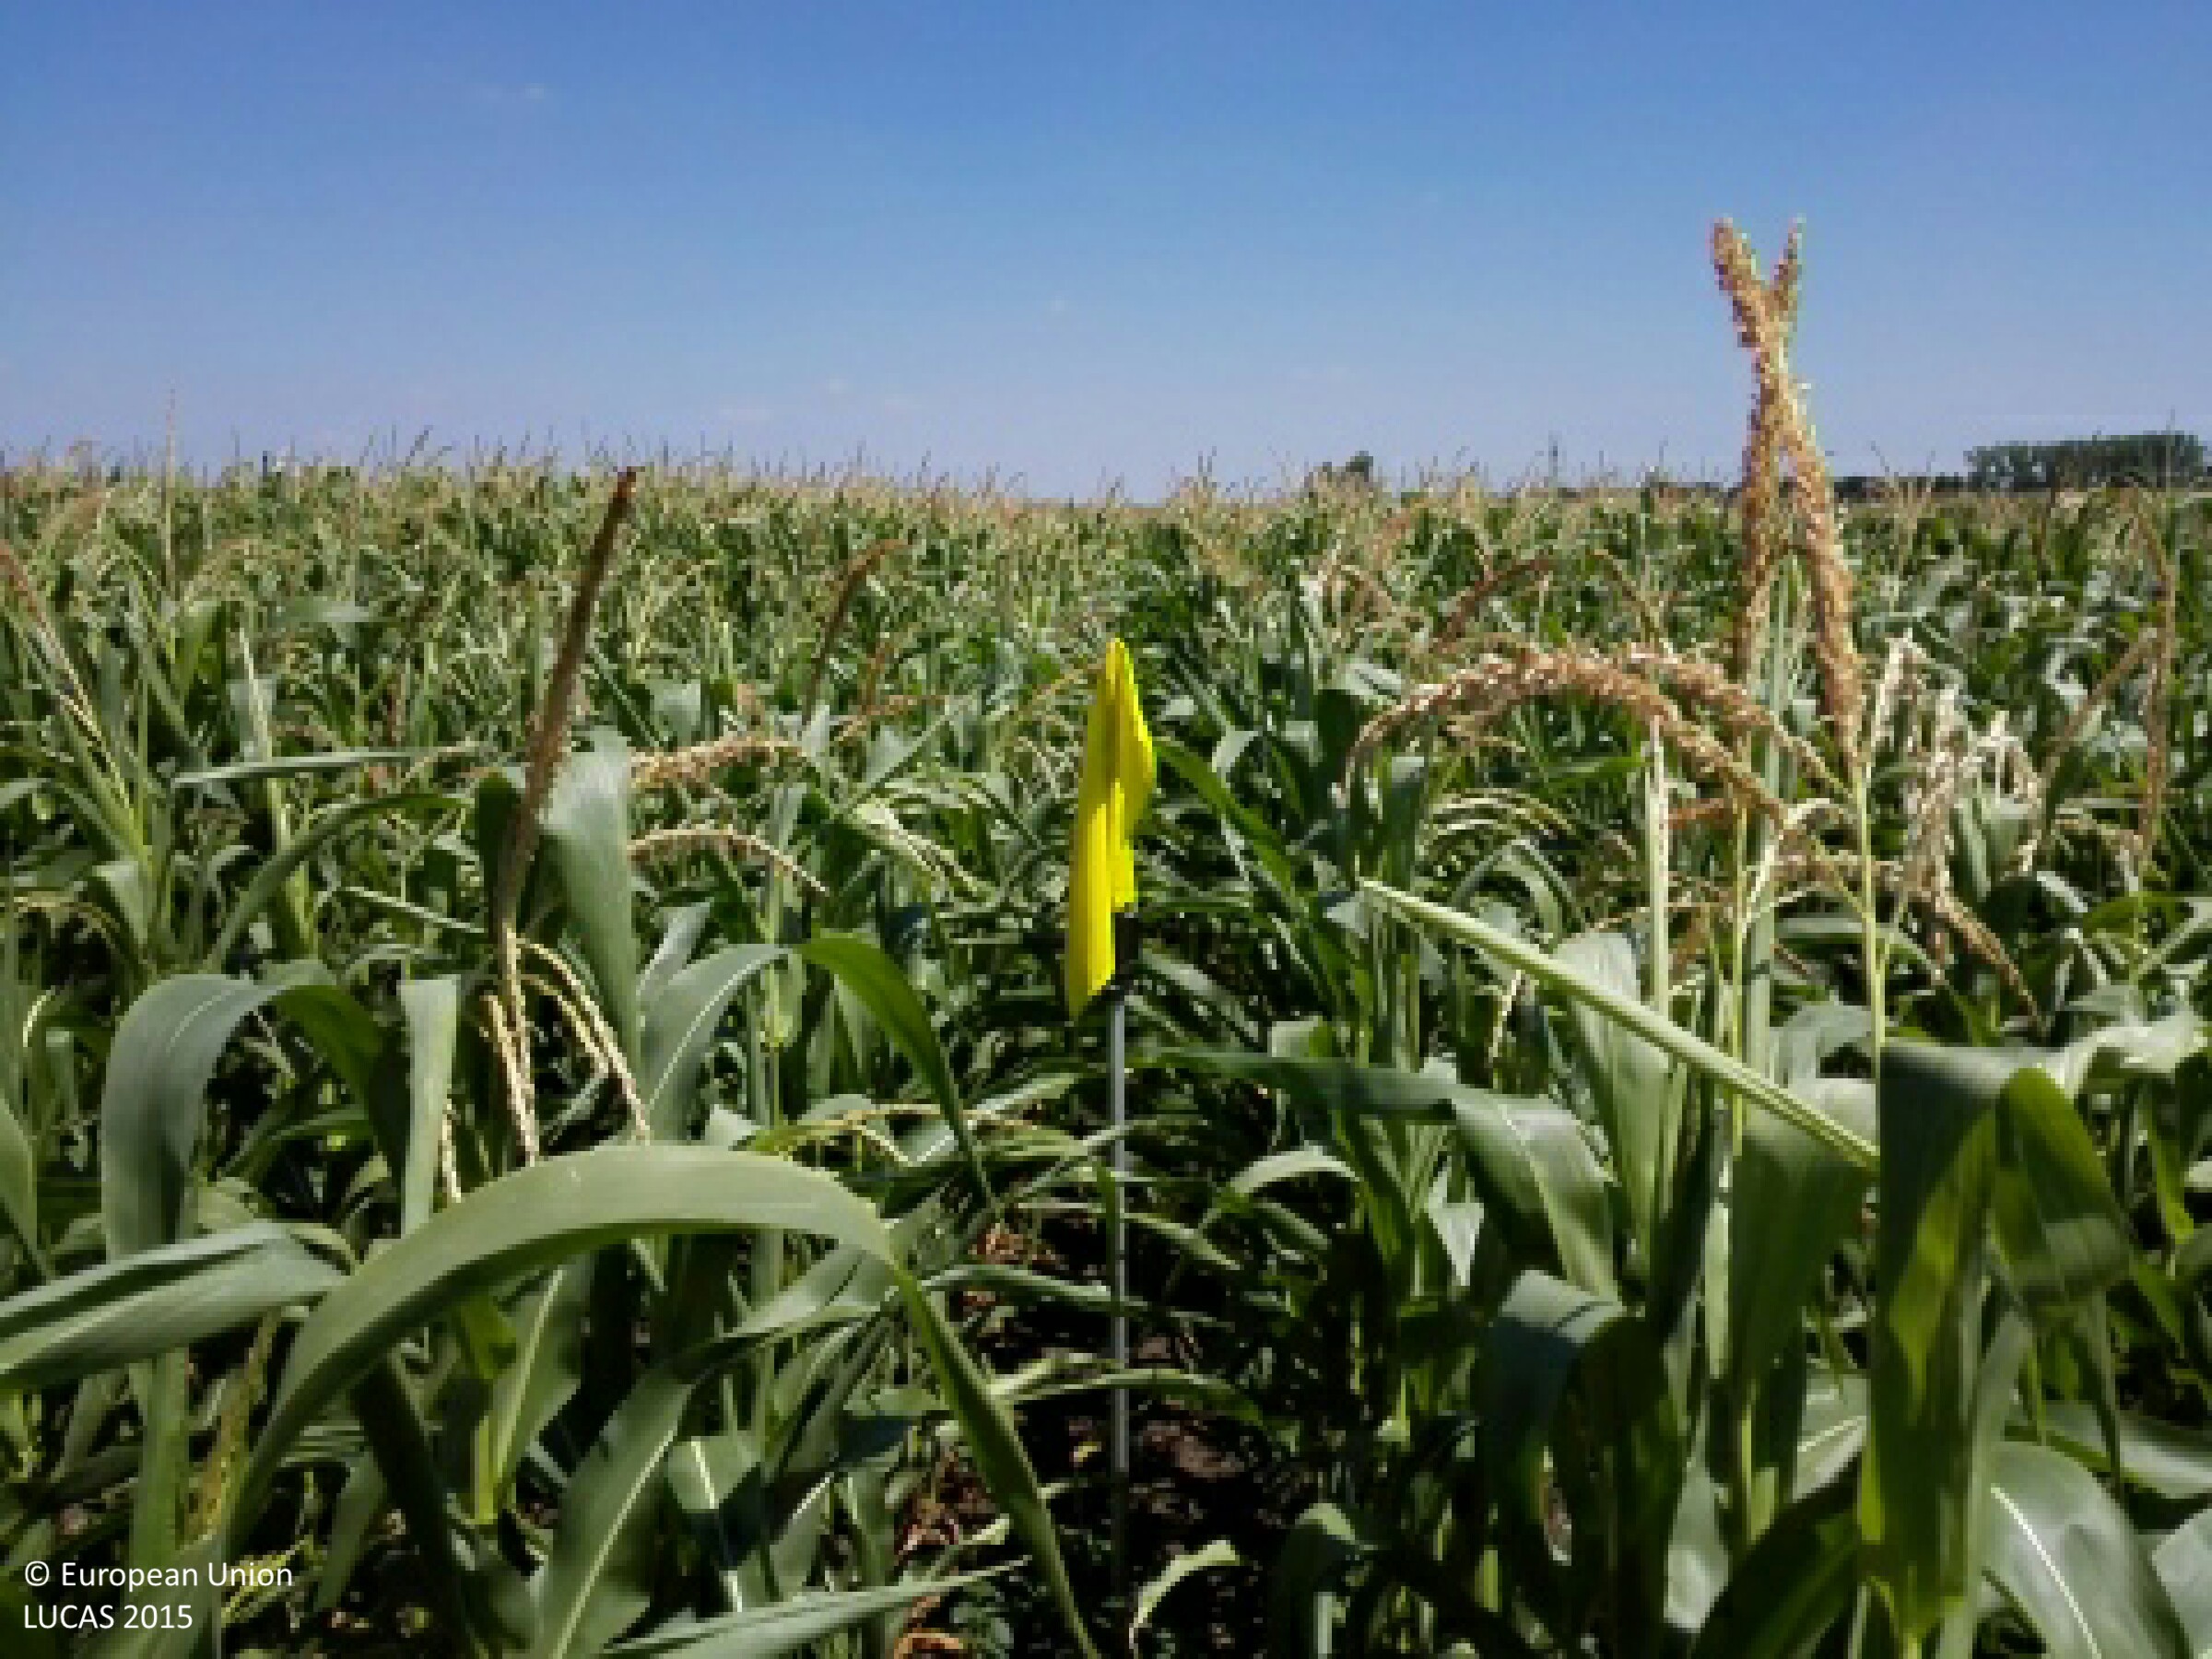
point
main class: Cropland
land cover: Maize
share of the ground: > 75 %
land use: Agriculture (excluding fallow land and kitchen gardens)
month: July
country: HU
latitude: 47.7755
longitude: 21.3994
